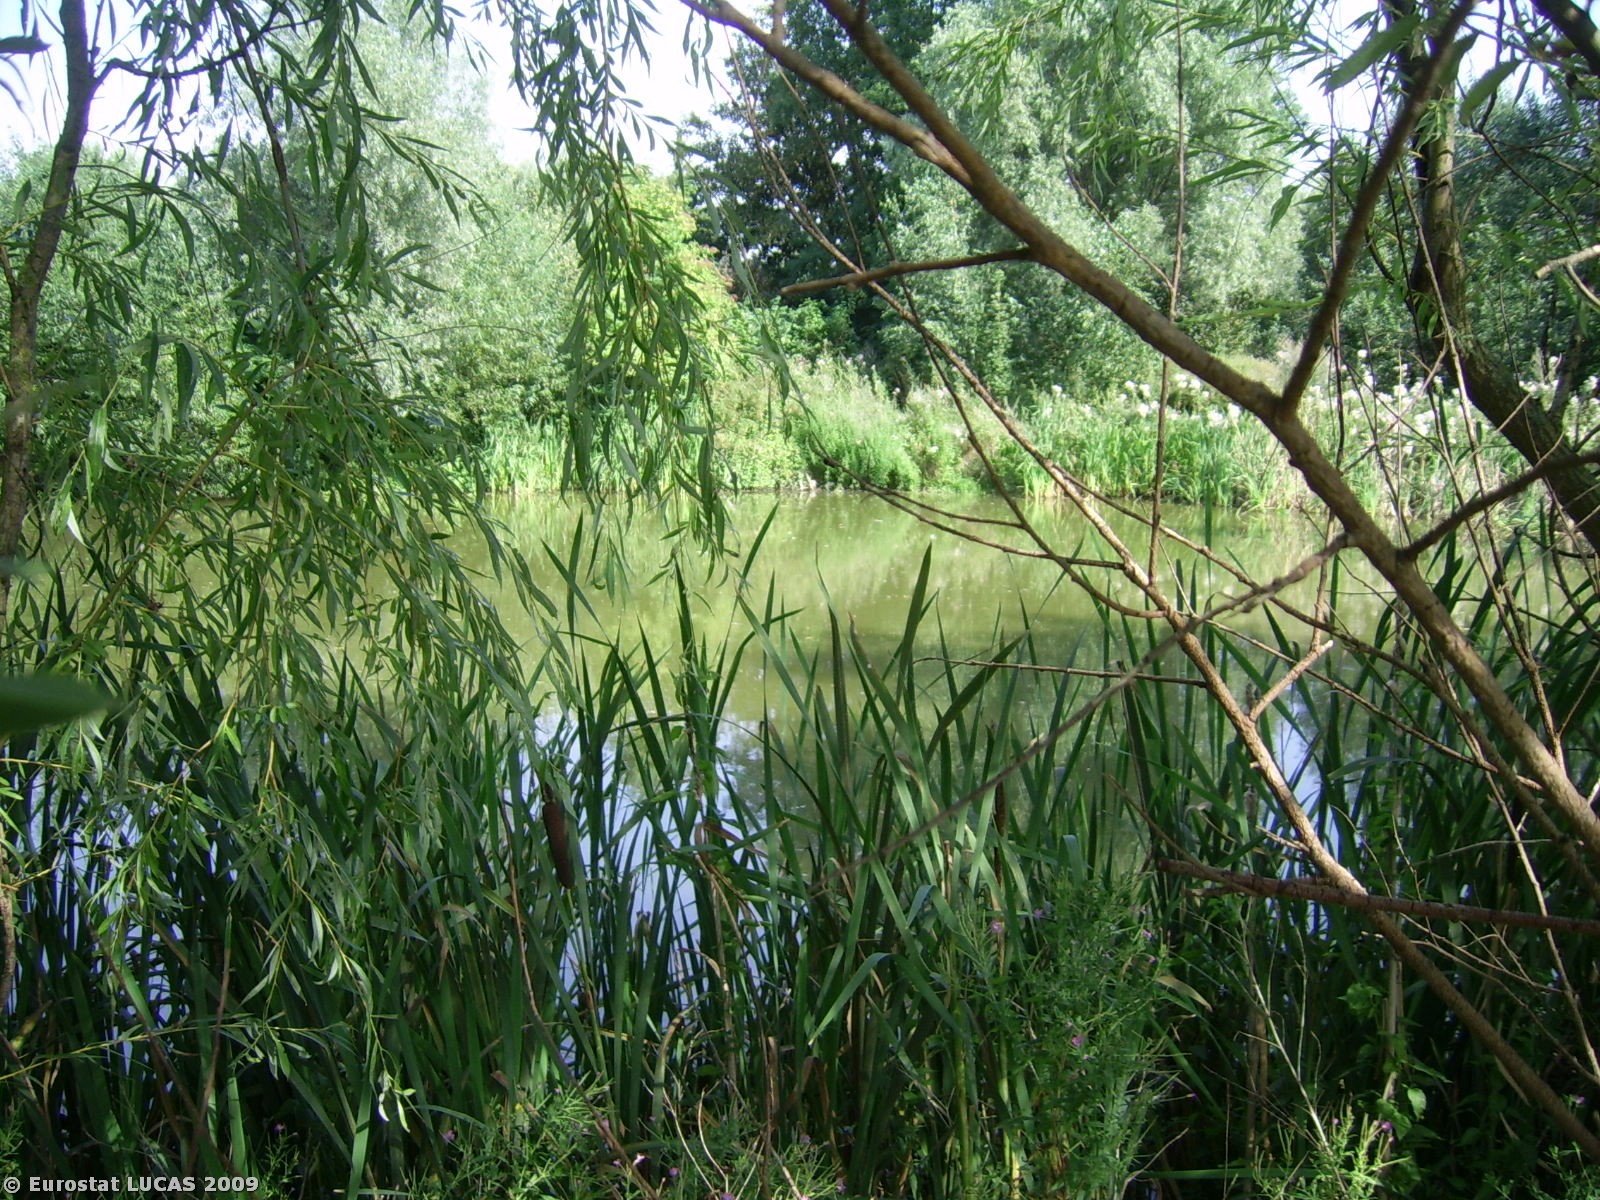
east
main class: Woodland
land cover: Broadleaved woodland
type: mesophytic deciduous forest
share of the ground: > 75 %
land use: Unused
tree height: > 5 m
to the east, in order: Broadleaved woodland; Inland water bodies; Broadleaved woodland; Grassland without tree/shrub cover; Artificial constructions in urban areas; Fences; Grassland without tree/shrub cover; Broadleaved woodland; Grassland without tree/shrub cover; Shrubland without tree cover; Rivers and streams; Grassland without tree/shrub cover; Rivers and streams; Abandoned hedges; Fences; Grassland without tree/shrub cover
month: August
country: PL
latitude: 53.2092
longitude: 18.7800
